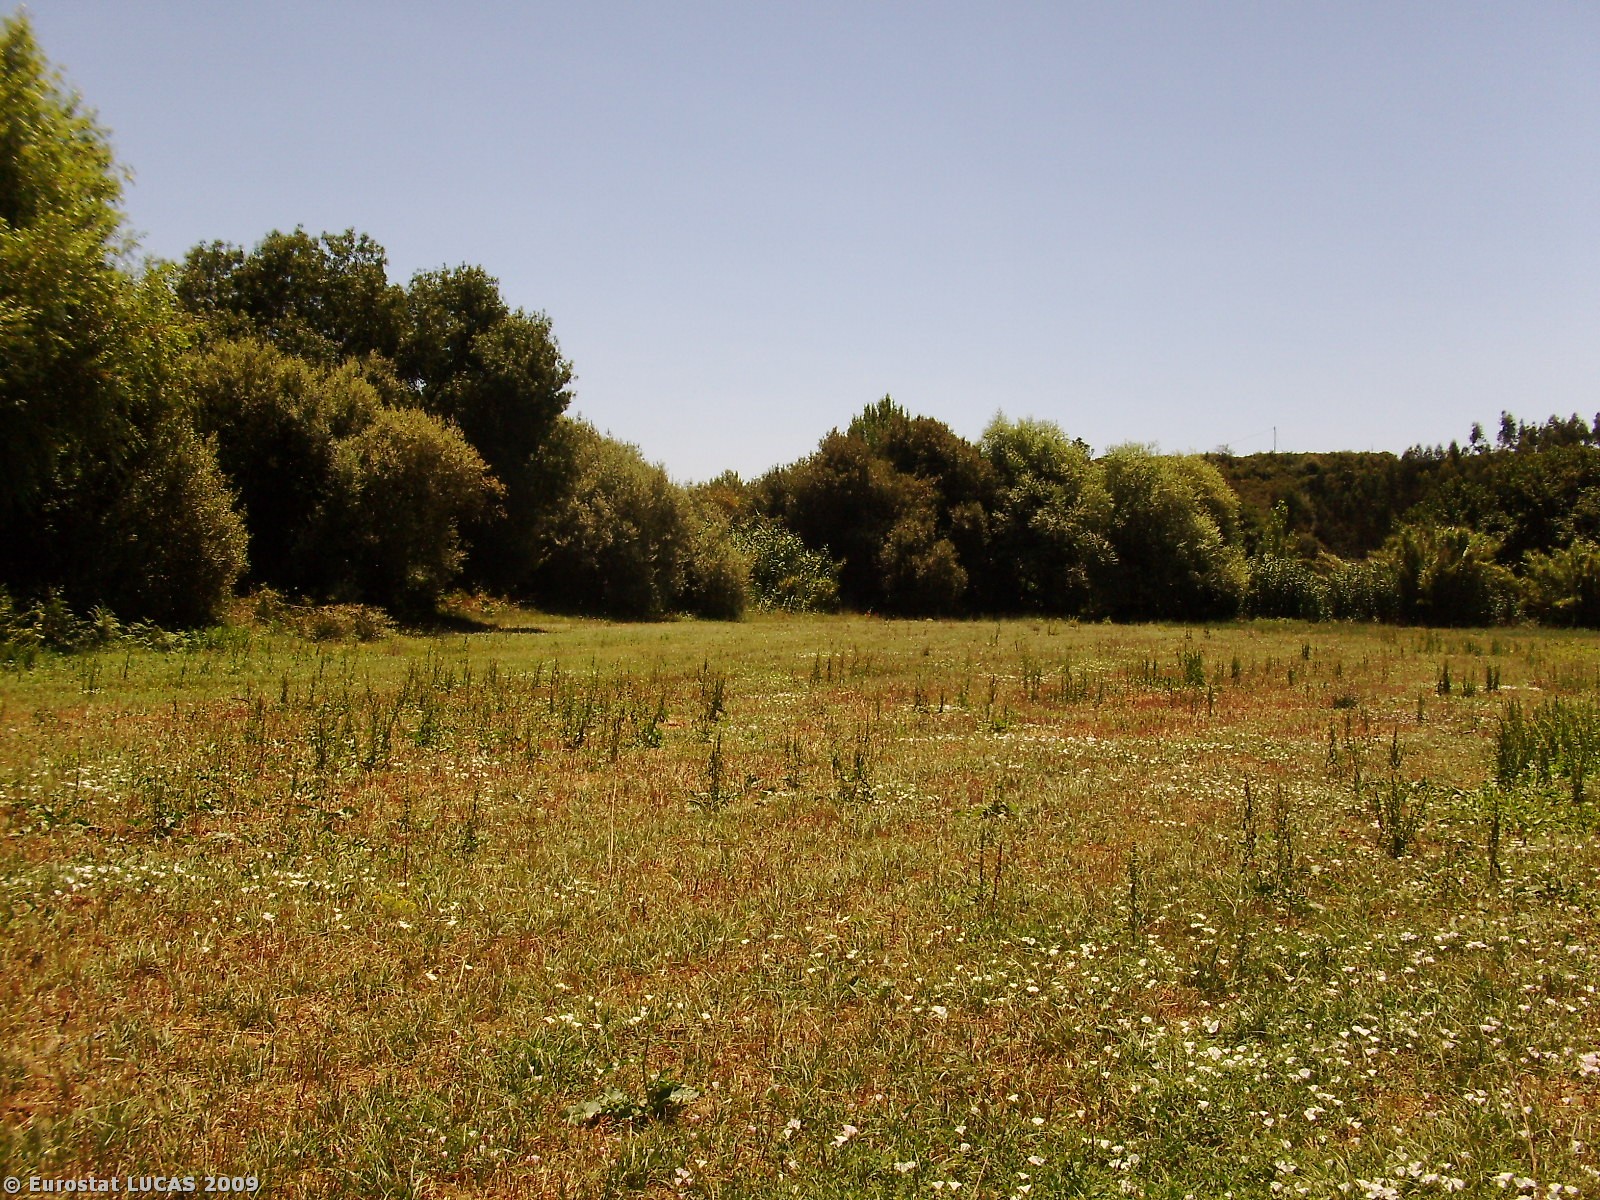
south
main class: Grassland
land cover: Grassland without tree/shrub cover
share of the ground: > 75 %
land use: Agriculture (excluding fallow land and kitchen gardens)
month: July
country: PT
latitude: 39.4012
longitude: -8.8582
